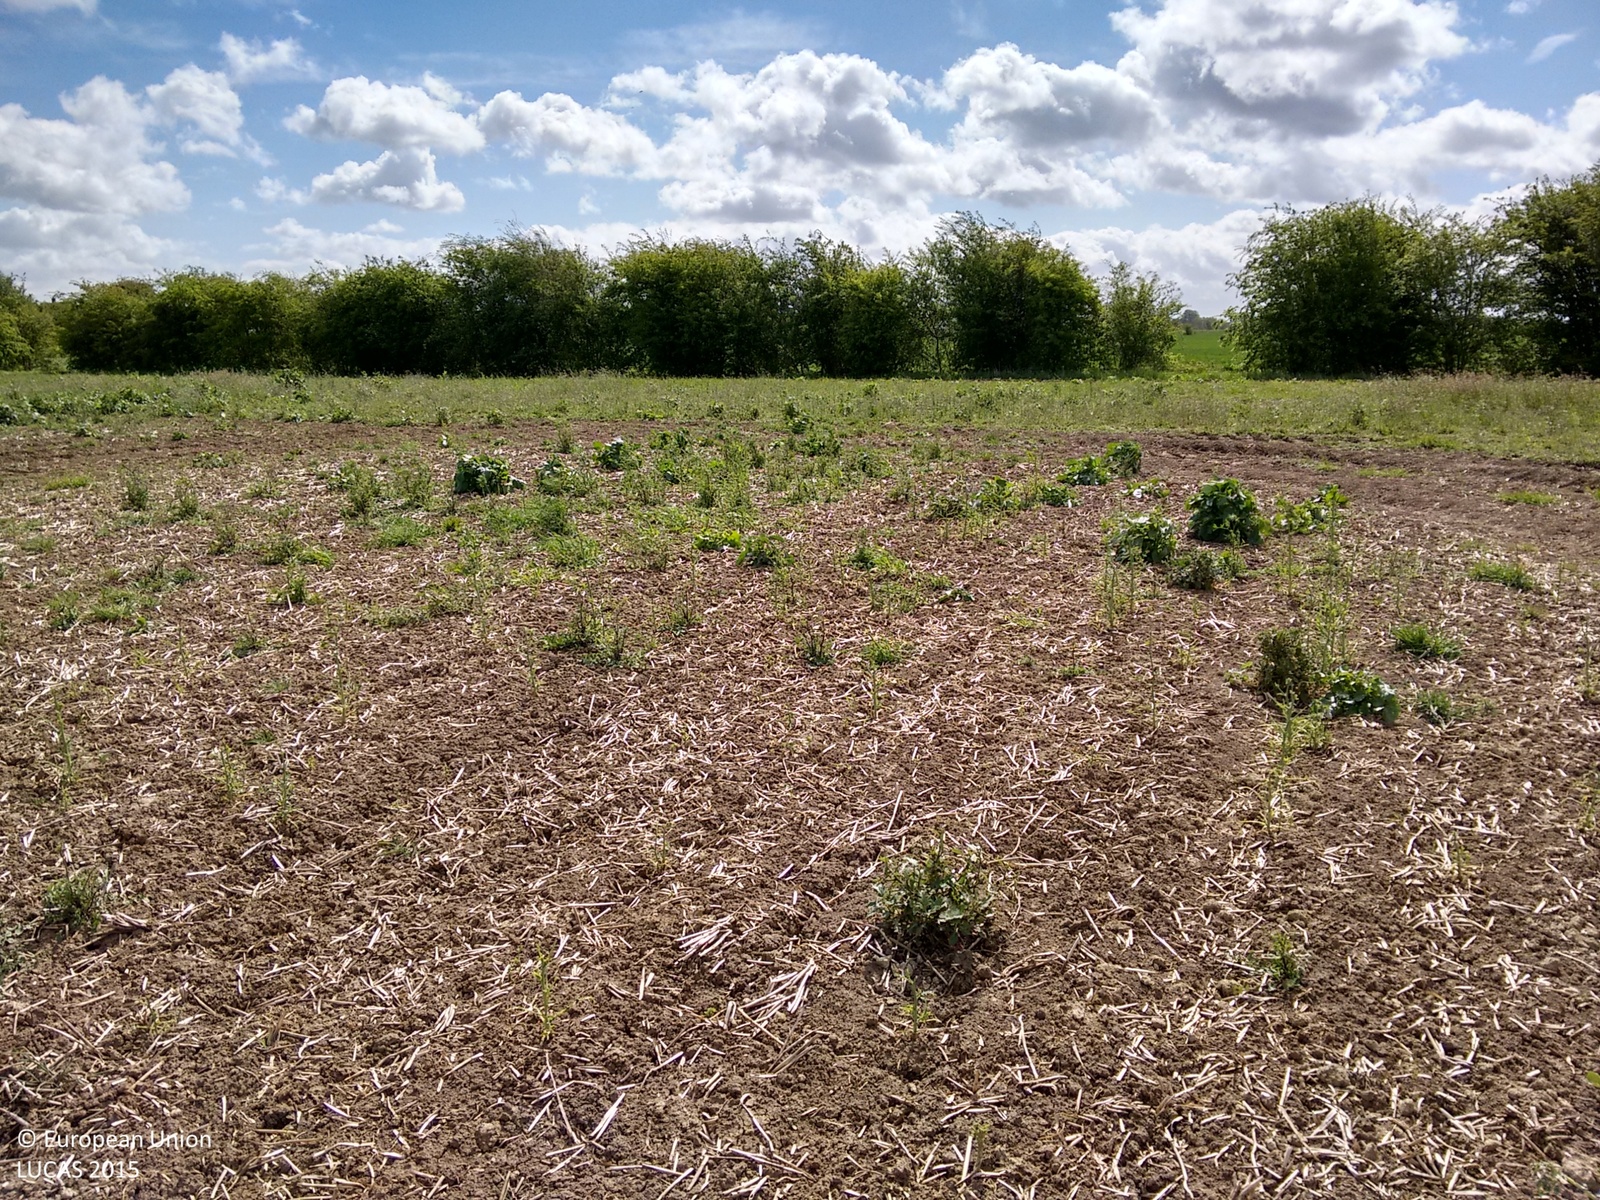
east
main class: Cropland
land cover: Rape and turnip rape
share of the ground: < 10 %
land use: Agriculture (excluding fallow land and kitchen gardens)
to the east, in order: Rape and turnip rape; Spontaneously vegetated surfaces; Grass margins; Managed hedges; Ditches and canals; Grass margins; Common wheat; Grass margins; Tracks; Grass margins; Inland fresh water bodies; Artificial constructions in urban areas
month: May
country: GB
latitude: 53.0331
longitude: -0.0988
